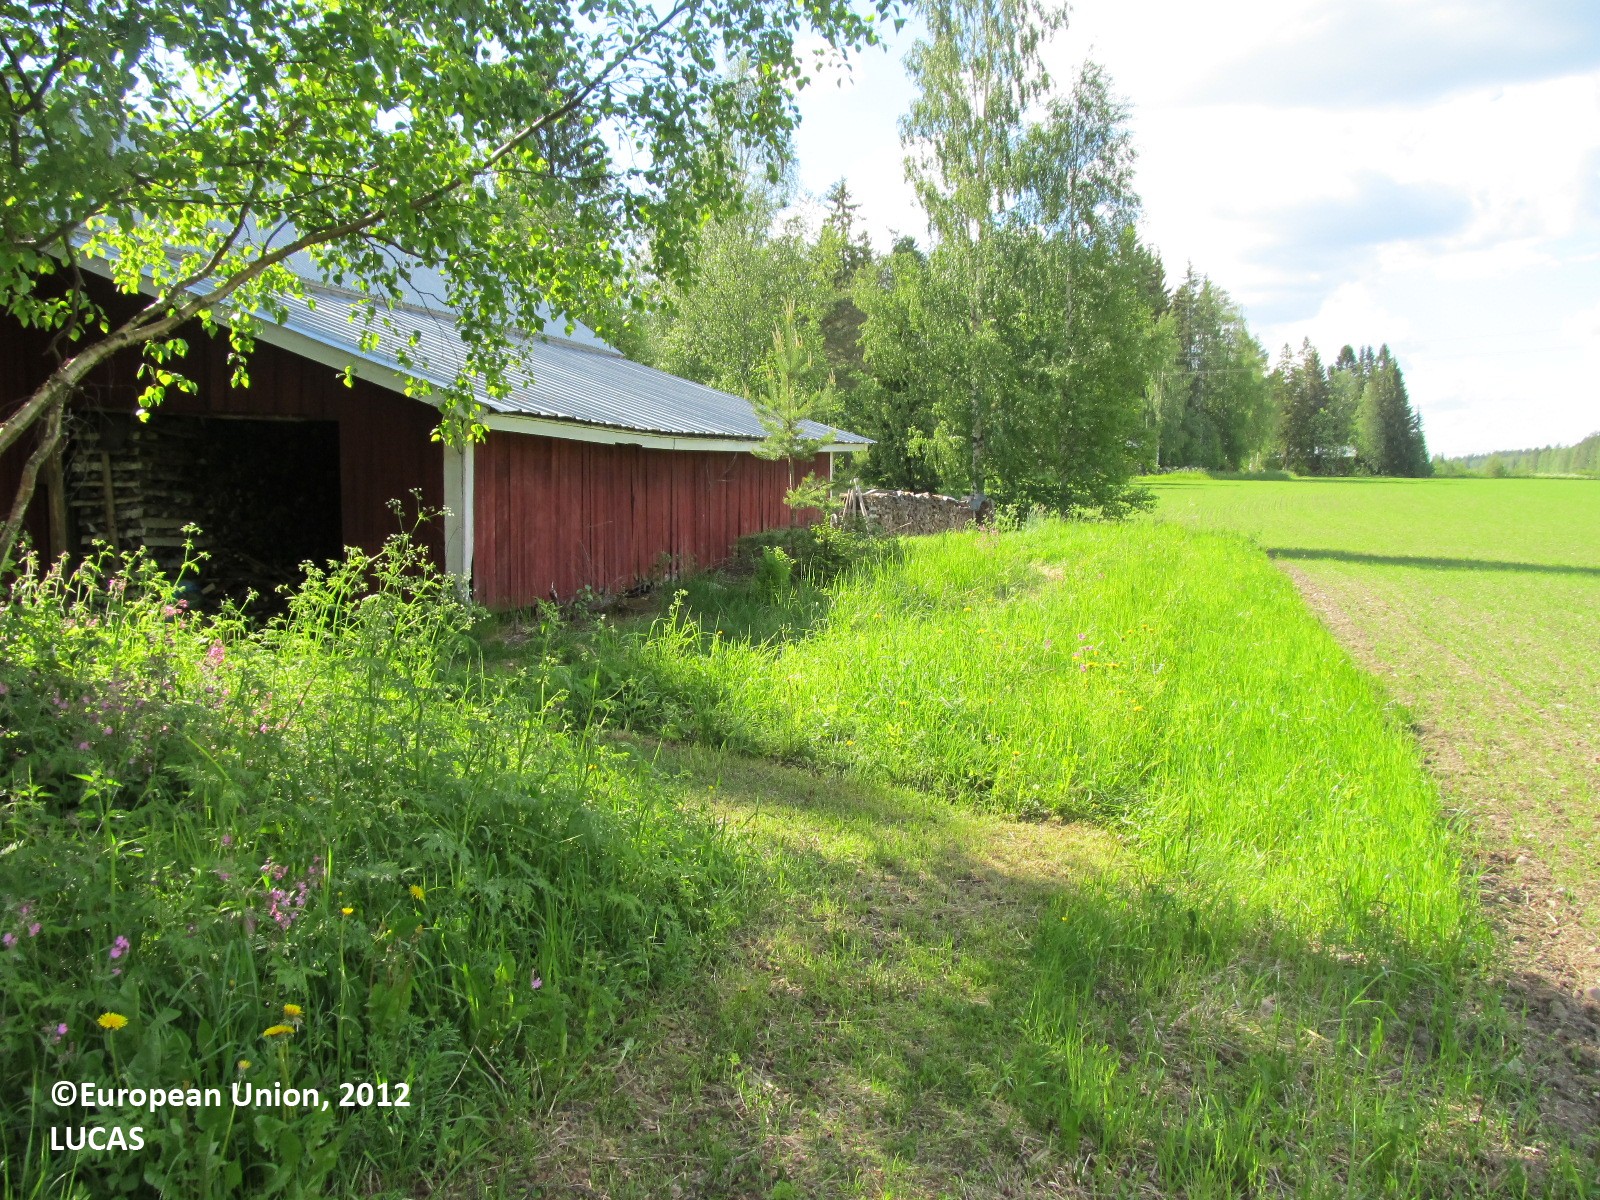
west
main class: Cropland
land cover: Temporary grasslands
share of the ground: 10 - 25 %
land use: Agriculture (excluding fallow land and kitchen gardens)
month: June
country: FI
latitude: 62.7406
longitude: 27.6860
